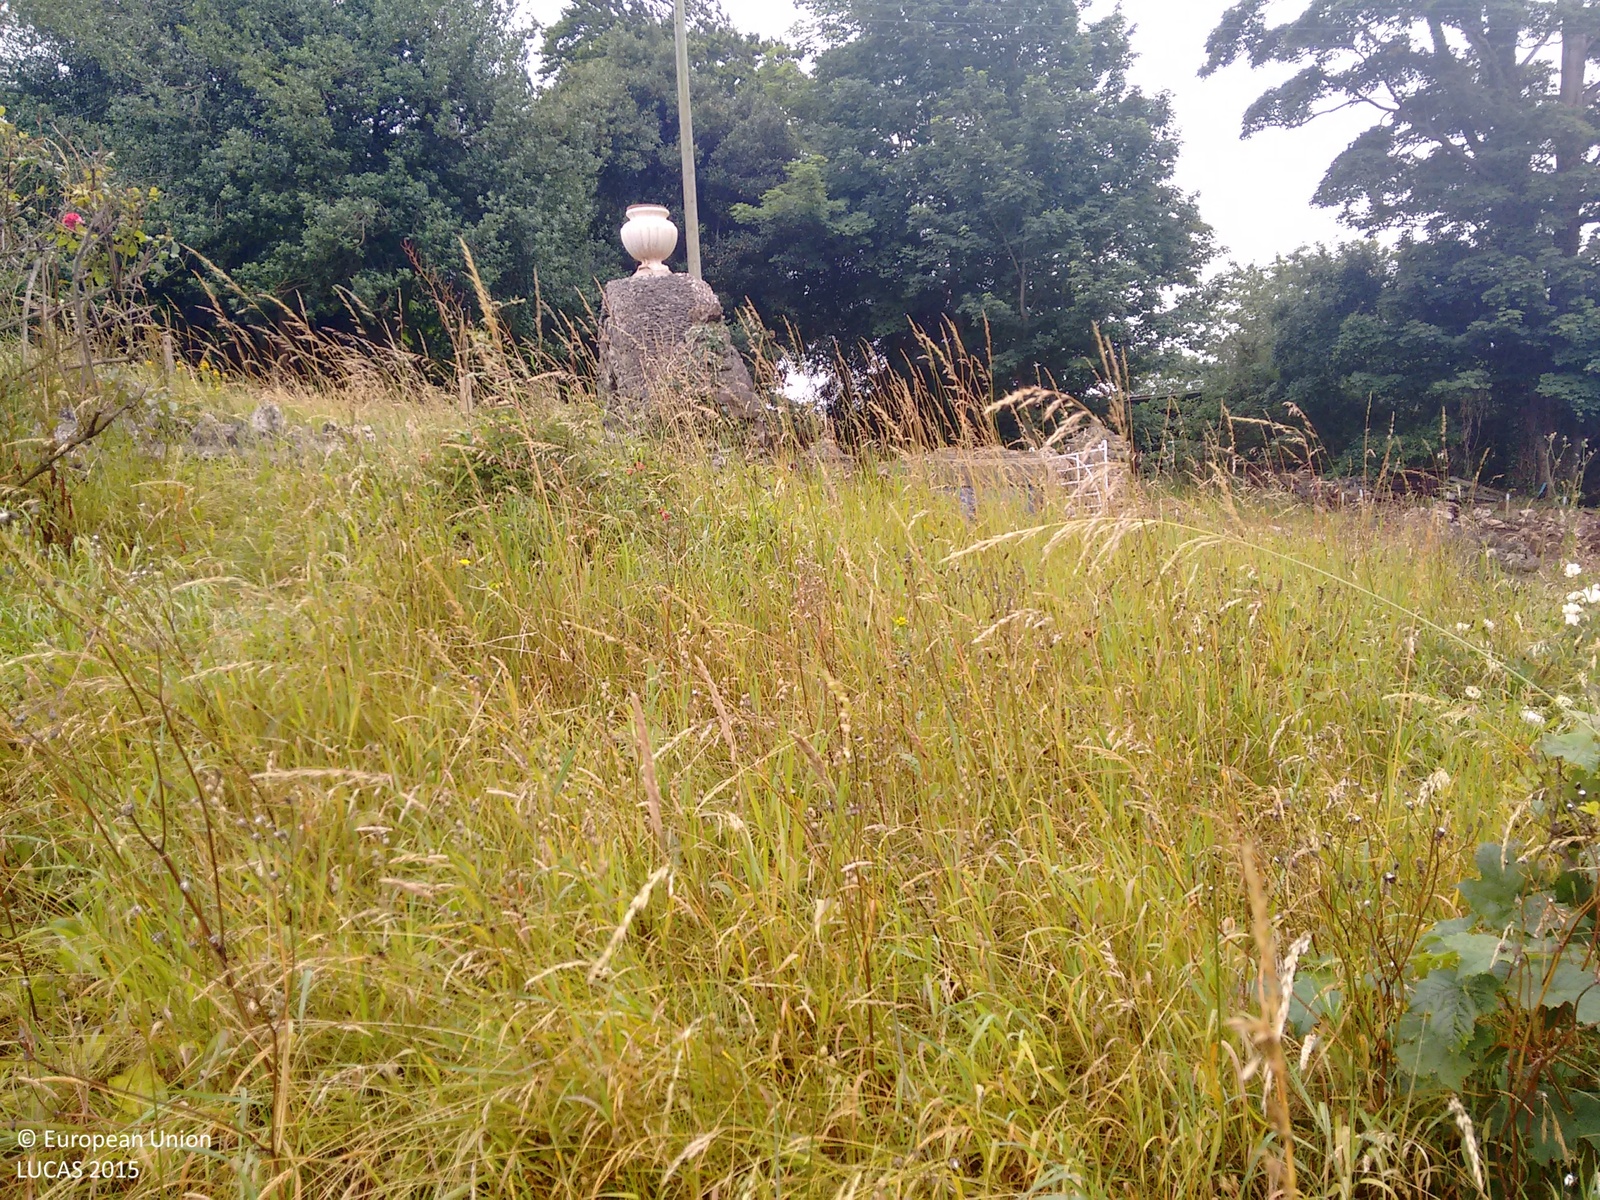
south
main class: Grassland
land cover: Grassland with sparse tree/shrub cover
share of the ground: > 75 %
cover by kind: herbaceous plants 95 %, broadleaved forest trees 5 %
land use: Residential
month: July
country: GB
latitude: 51.3251
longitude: -2.8880
